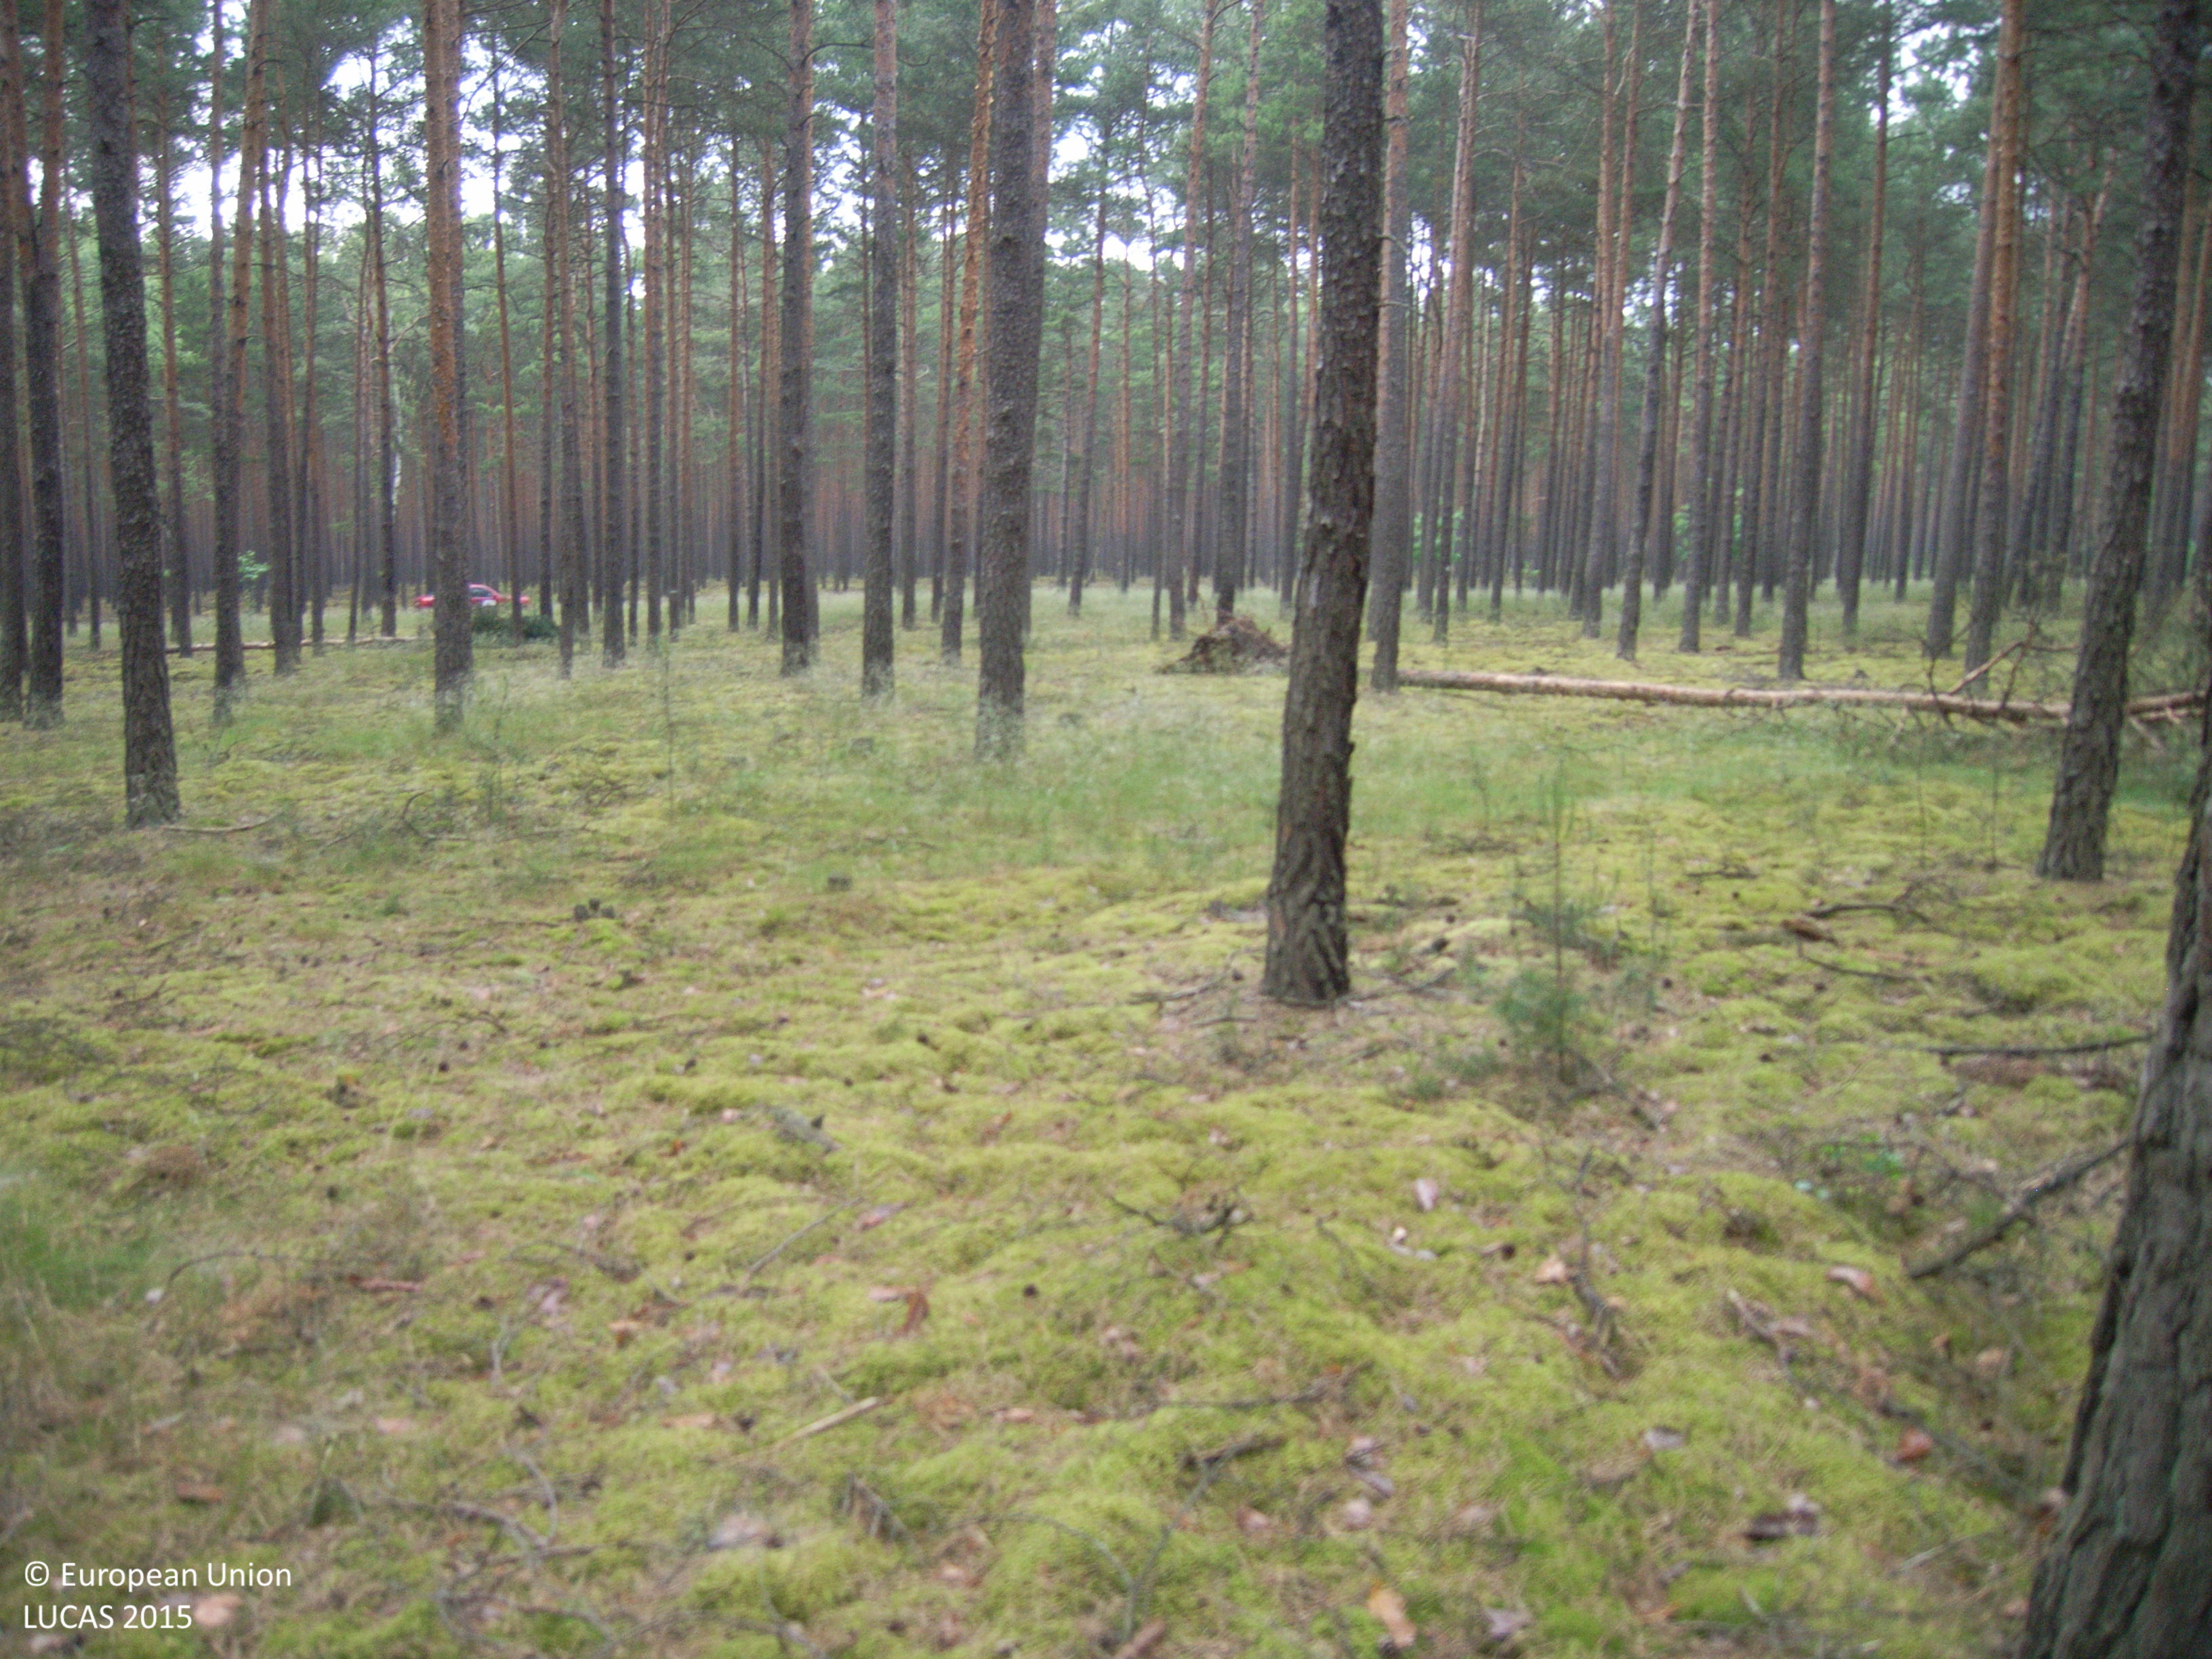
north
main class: Woodland
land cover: Pine dominated coniferous woodland
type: hemiboreal forest and nemoral coniferous forest and mixed broadleaved-coniferous forest
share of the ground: > 75 %
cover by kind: coniferous forest trees 100 %
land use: Forestry
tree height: > 5 m
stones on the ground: < 10 %
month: June
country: DE
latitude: 52.0443
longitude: 14.3902
